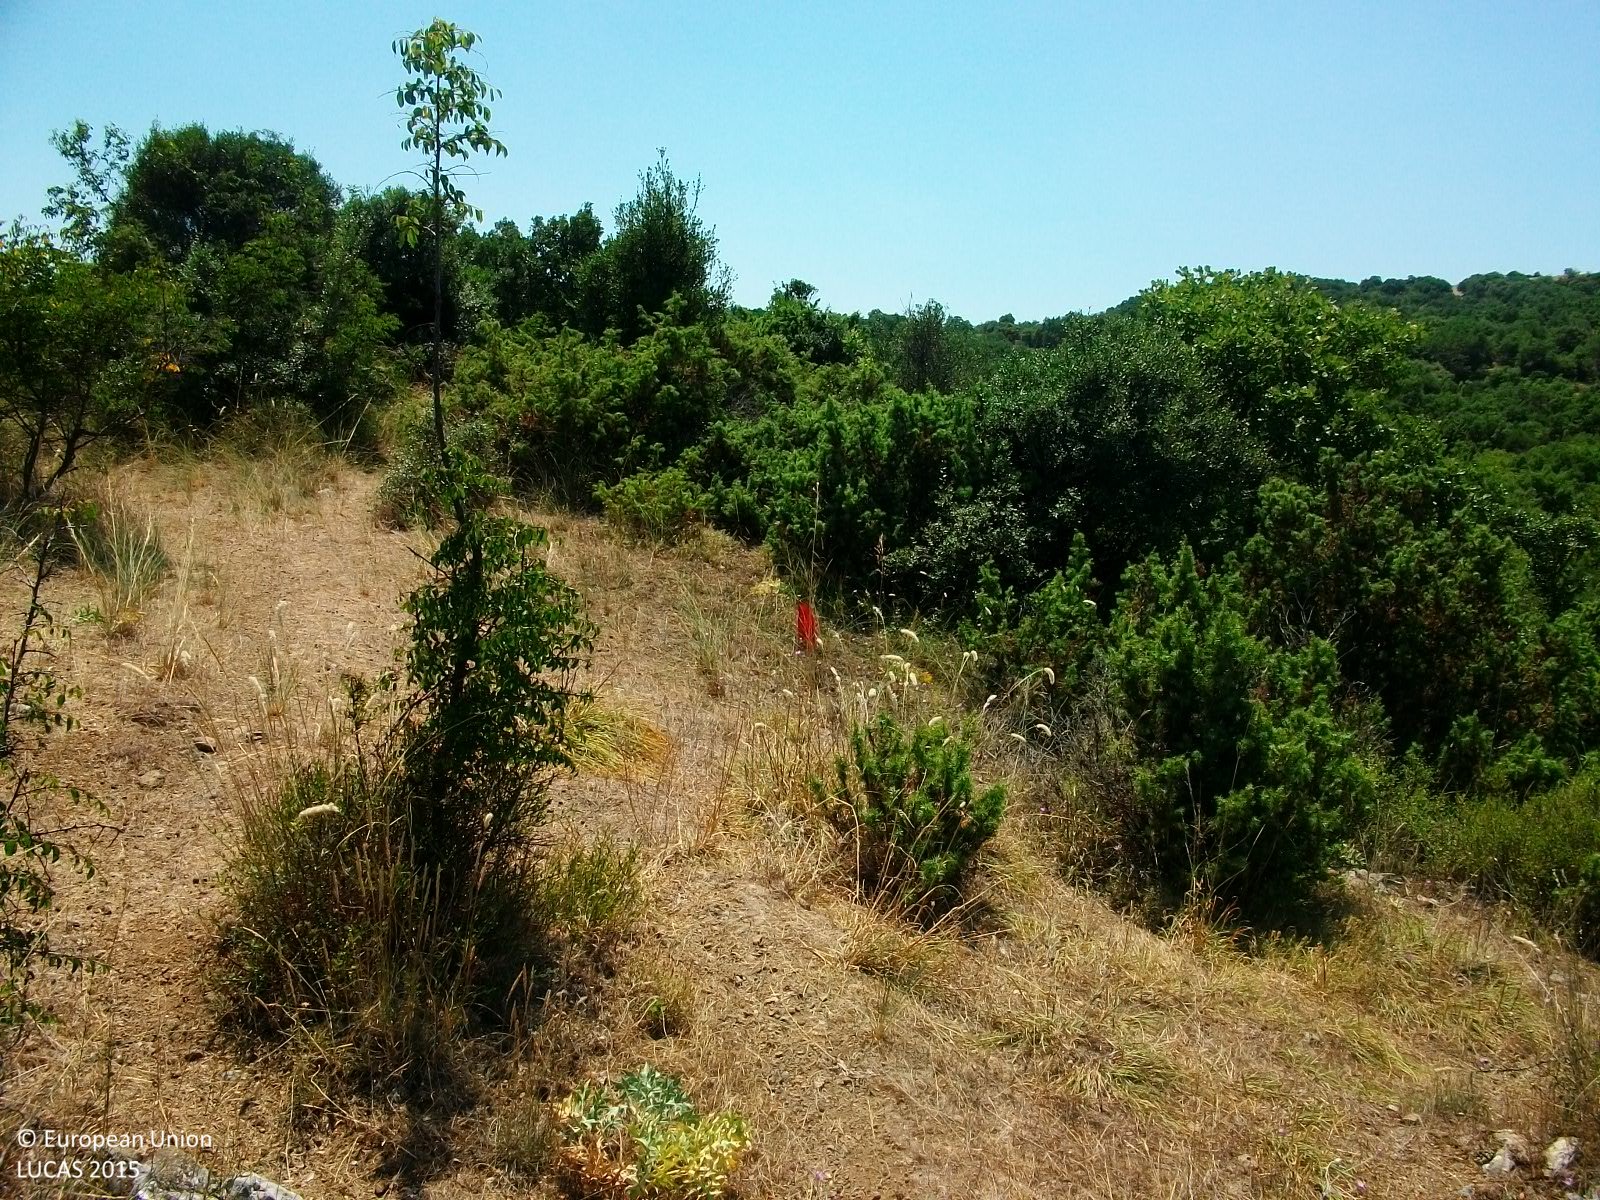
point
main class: Shrubland
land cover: Shrubland with sparse tree cover
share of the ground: 50 - 75 %
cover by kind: shrubs 70 %, herbaceous plants 25 %, broadleaved forest trees 5 %
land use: Semi-natural and natural areas not in use
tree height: < 5 m
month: July
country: GR
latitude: 40.9245
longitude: 26.1534
